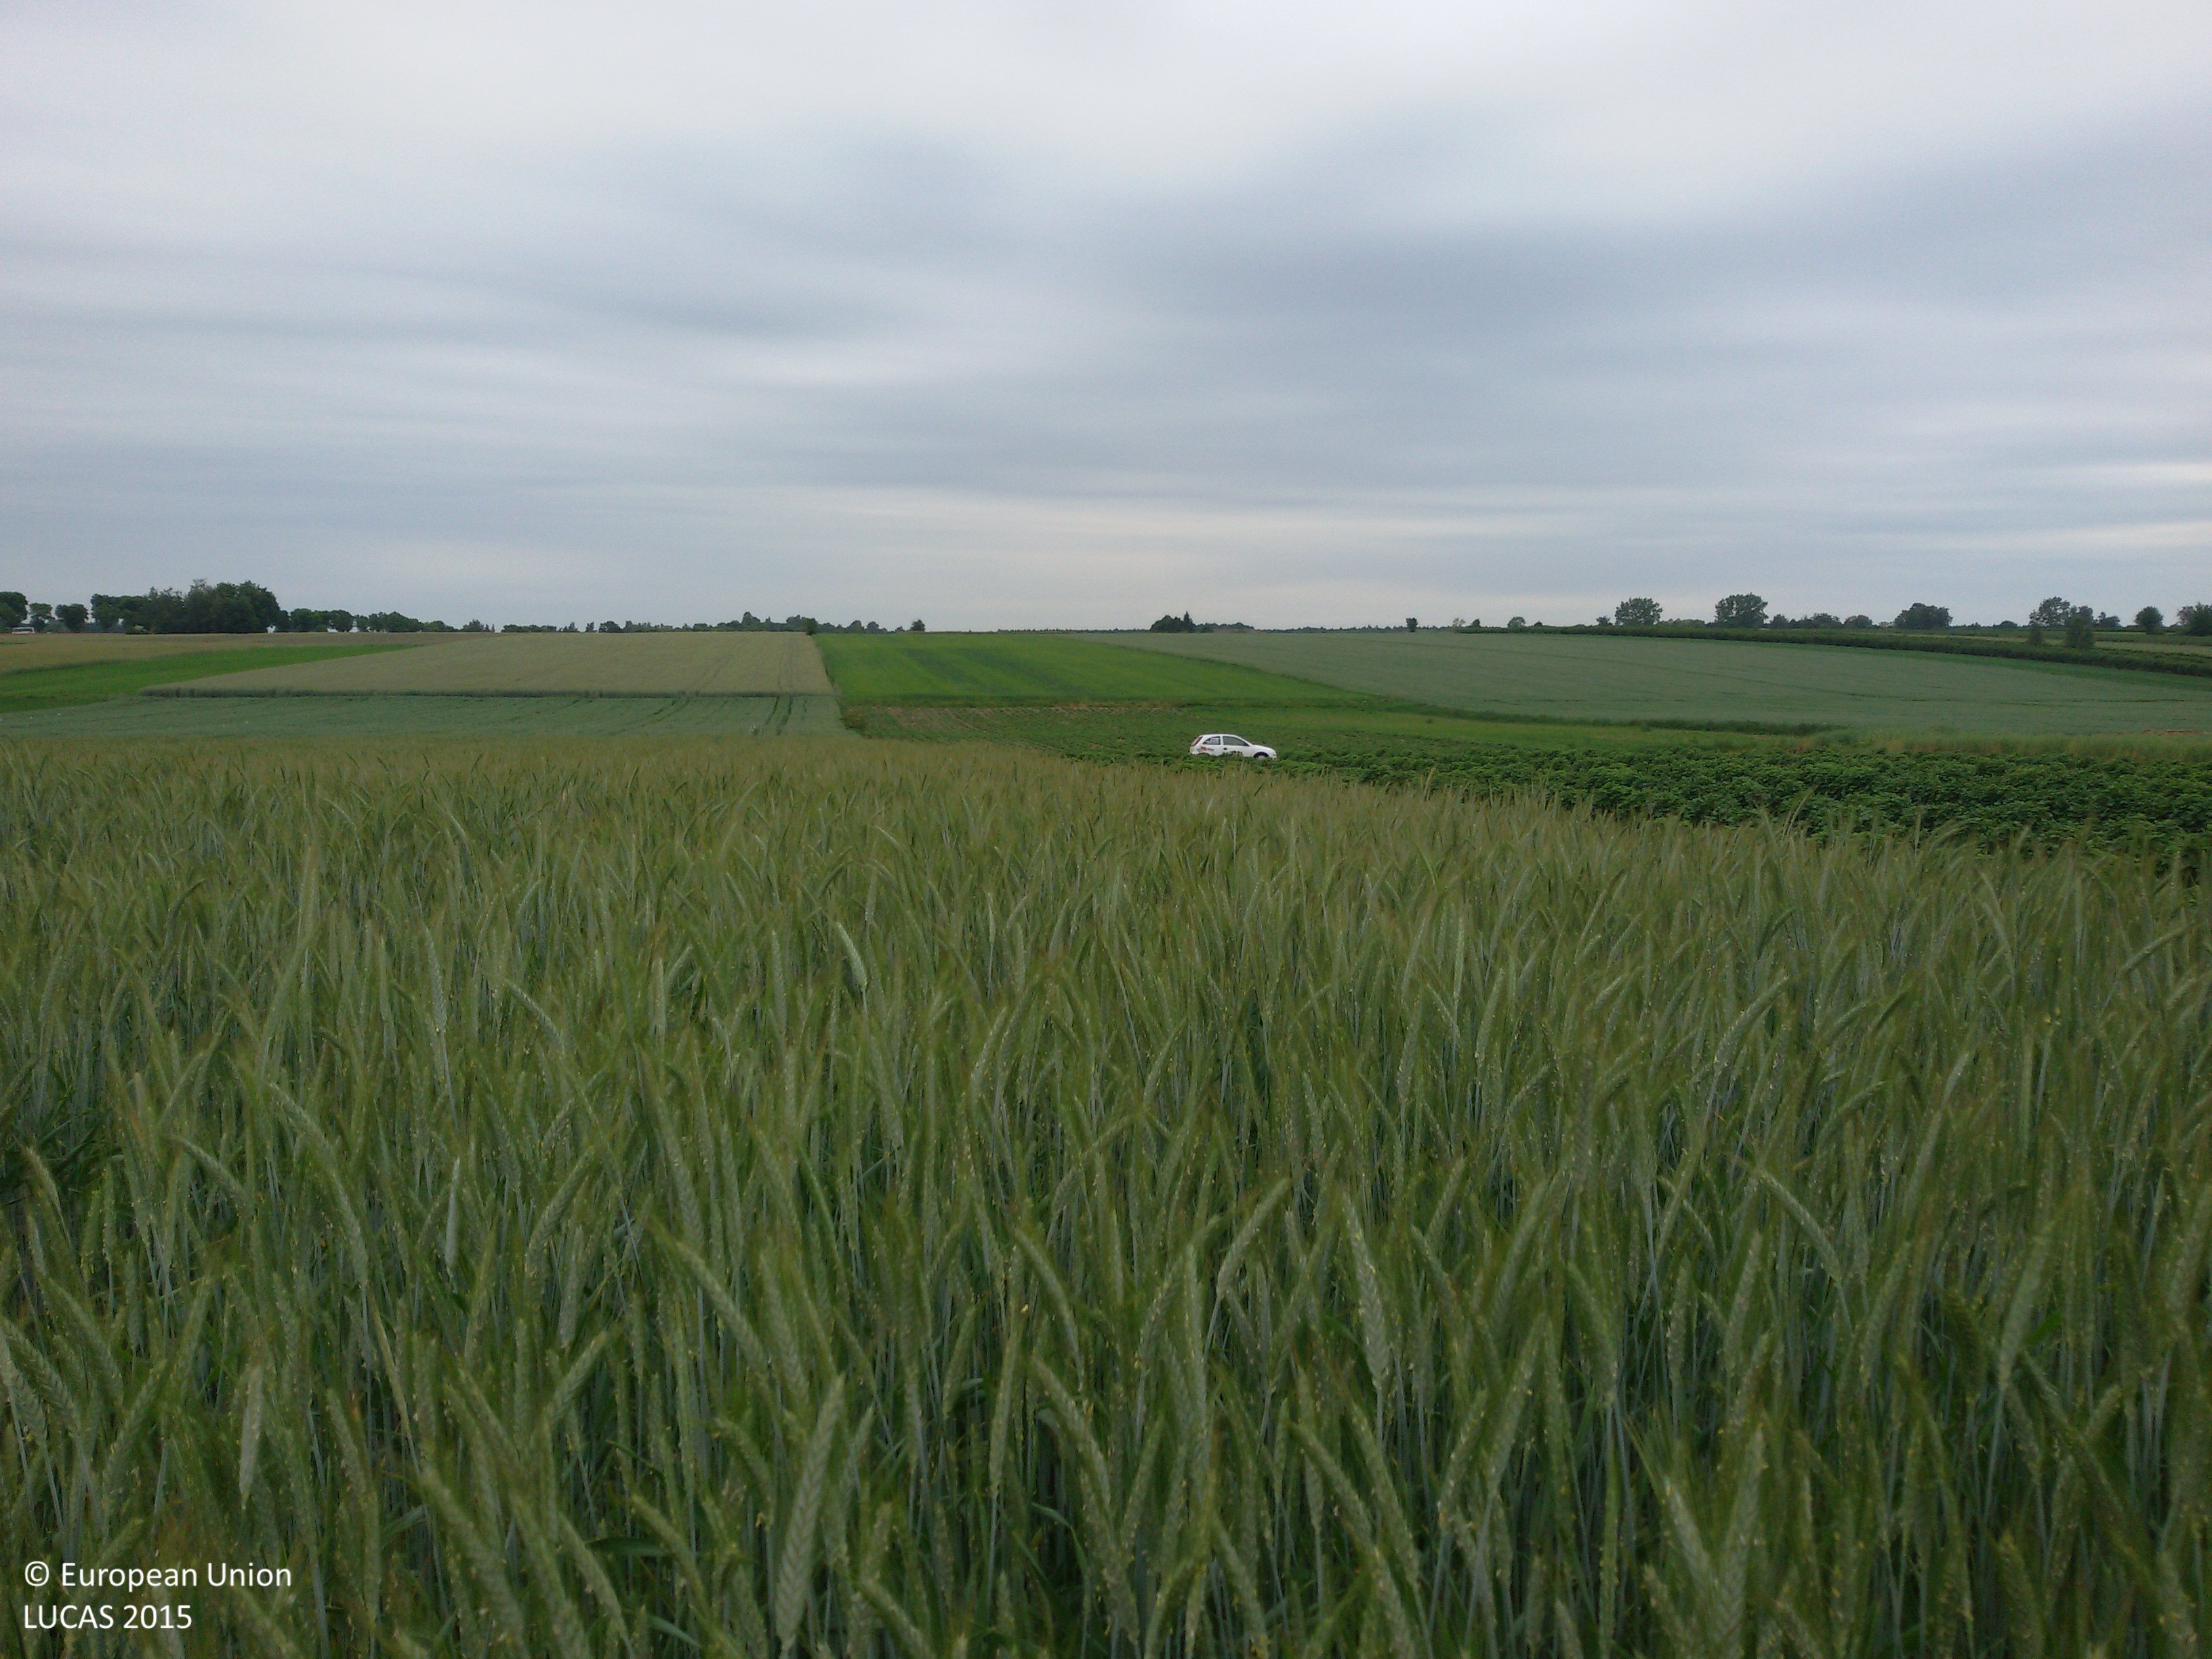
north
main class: Cropland
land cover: Triticale
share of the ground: > 75 %
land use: Agriculture (excluding fallow land and kitchen gardens)
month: June
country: PL
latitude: 51.8928
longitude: 19.8690
